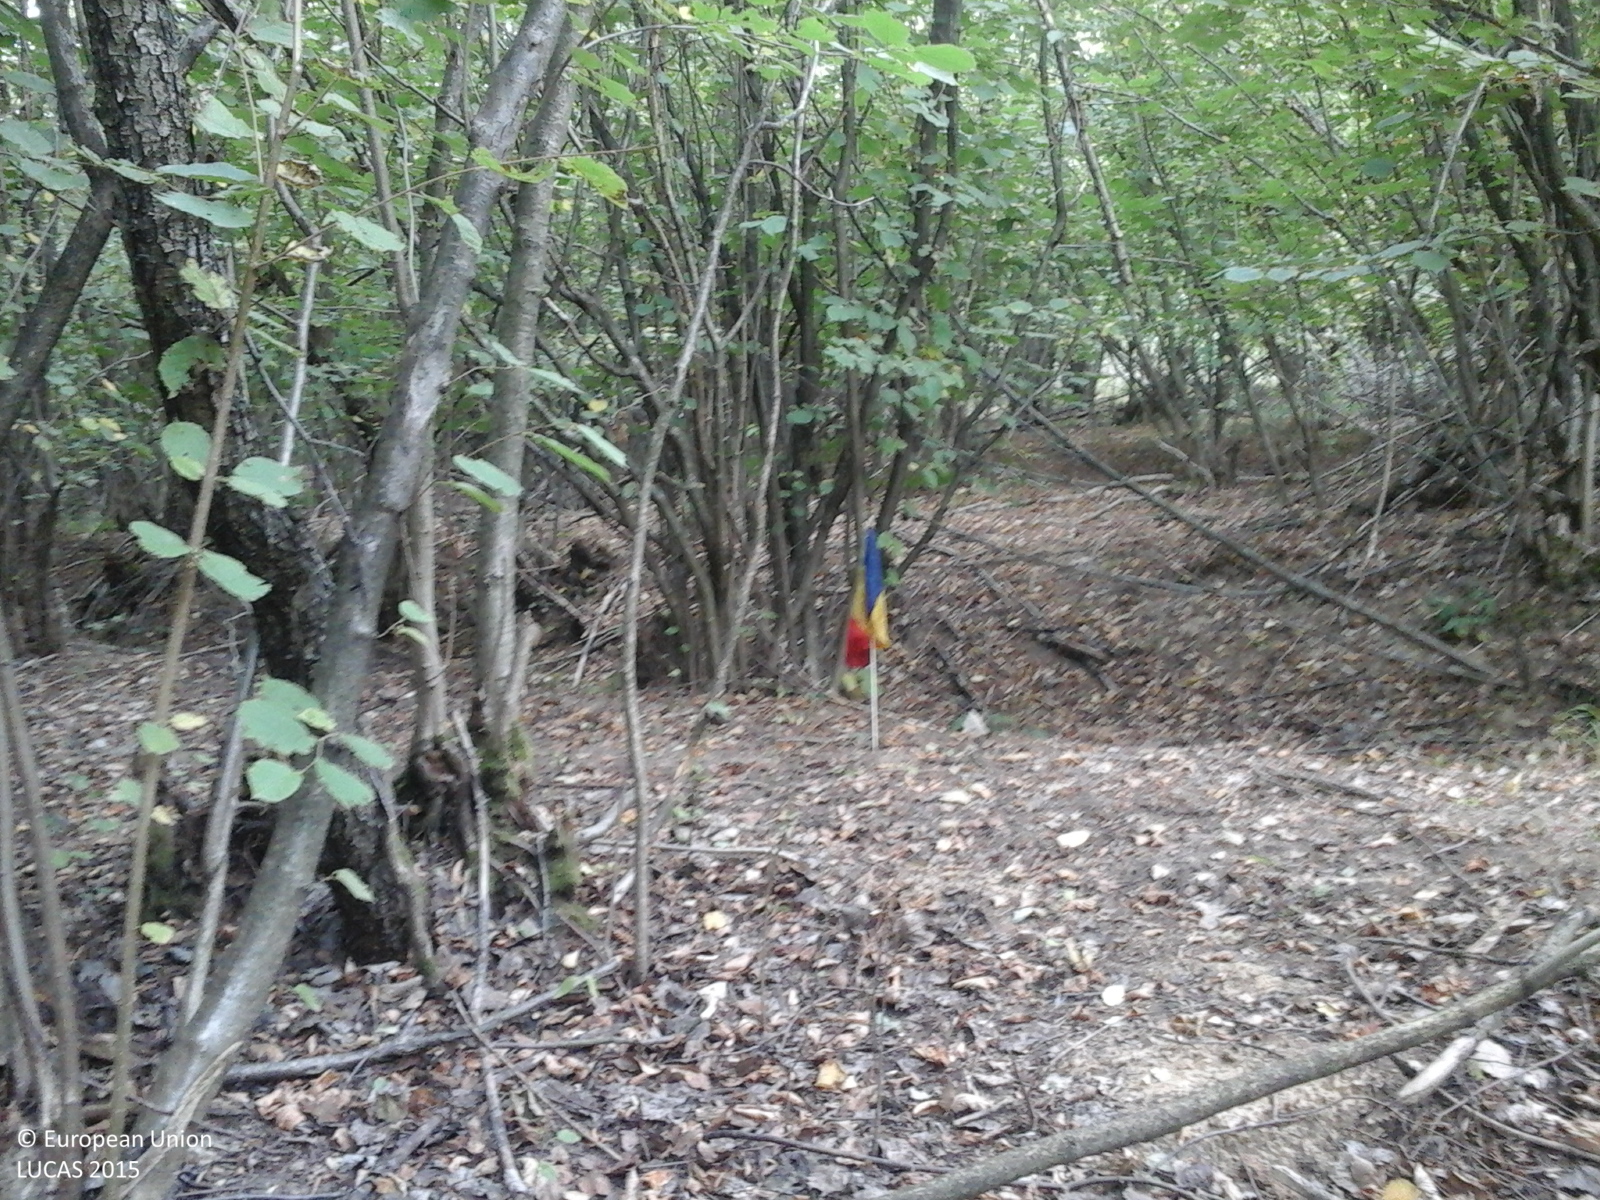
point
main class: Woodland
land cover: Broadleaved woodland
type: non-riverine alder, birch or aspen forest
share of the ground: > 75 %
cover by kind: broadleaved forest trees 100 %
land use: Forestry
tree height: > 5 m
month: September
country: RO
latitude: 47.9509
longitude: 23.6703
